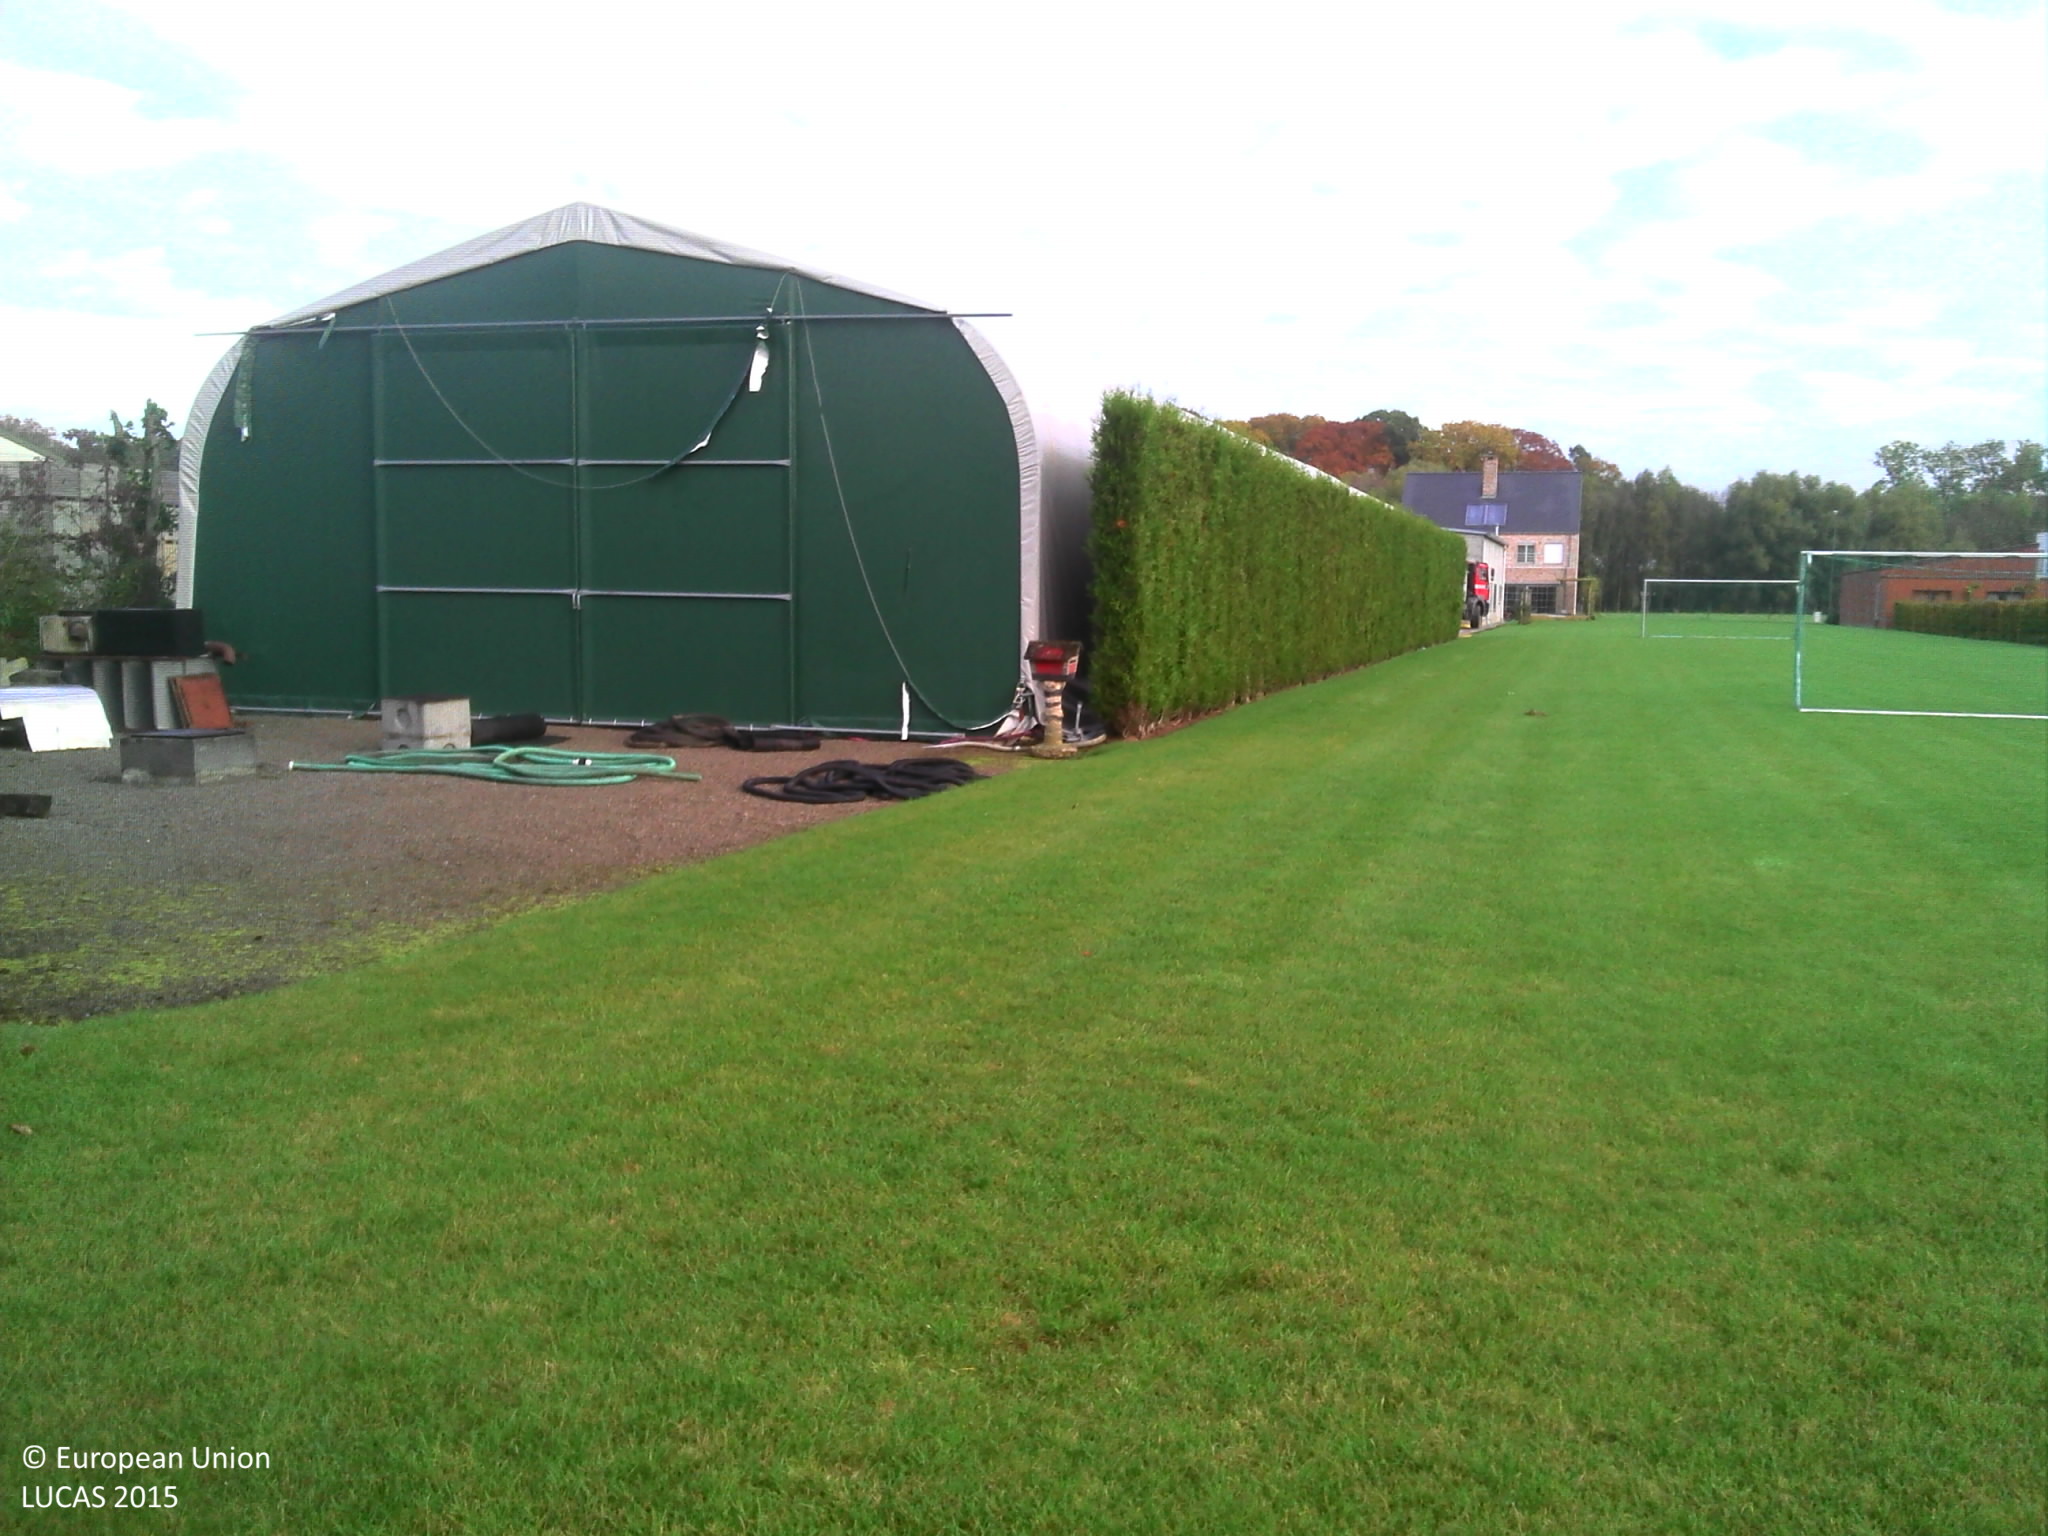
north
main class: Grassland
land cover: Grassland without tree/shrub cover
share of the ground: > 75 %
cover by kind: herbaceous plants 100 %
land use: Residential
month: October
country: BE
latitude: 50.9561
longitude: 4.5720
